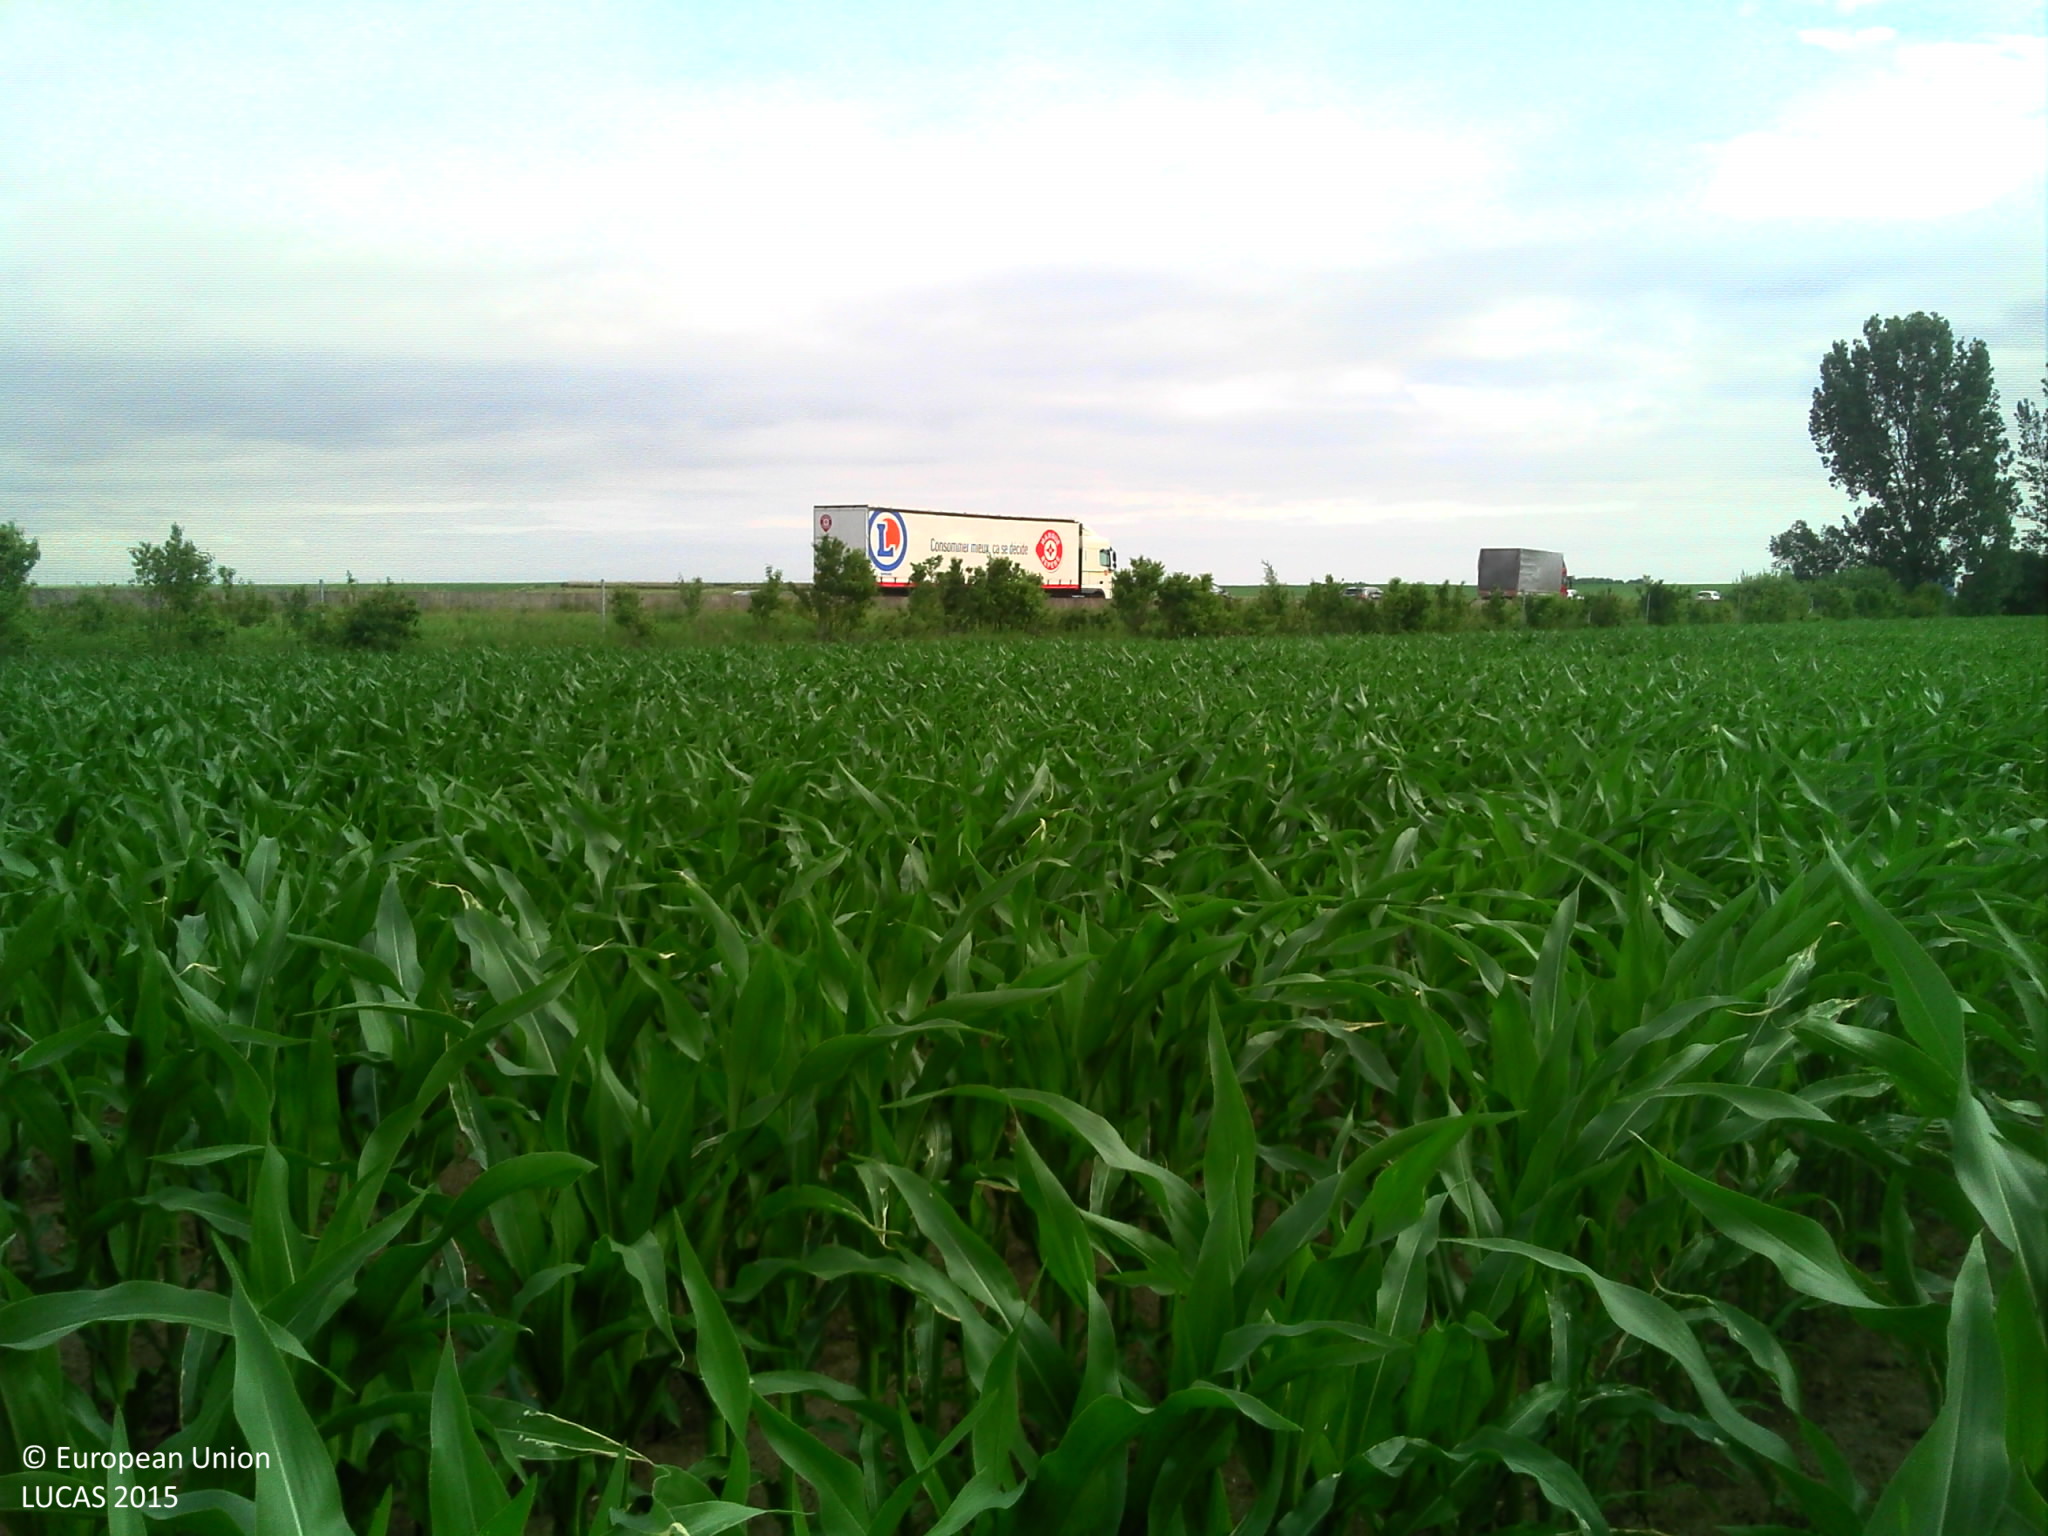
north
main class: Cropland
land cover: Maize
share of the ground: 25 - 50 %
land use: Agriculture (excluding fallow land and kitchen gardens)
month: June
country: FR
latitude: 48.4844
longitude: 7.5520
